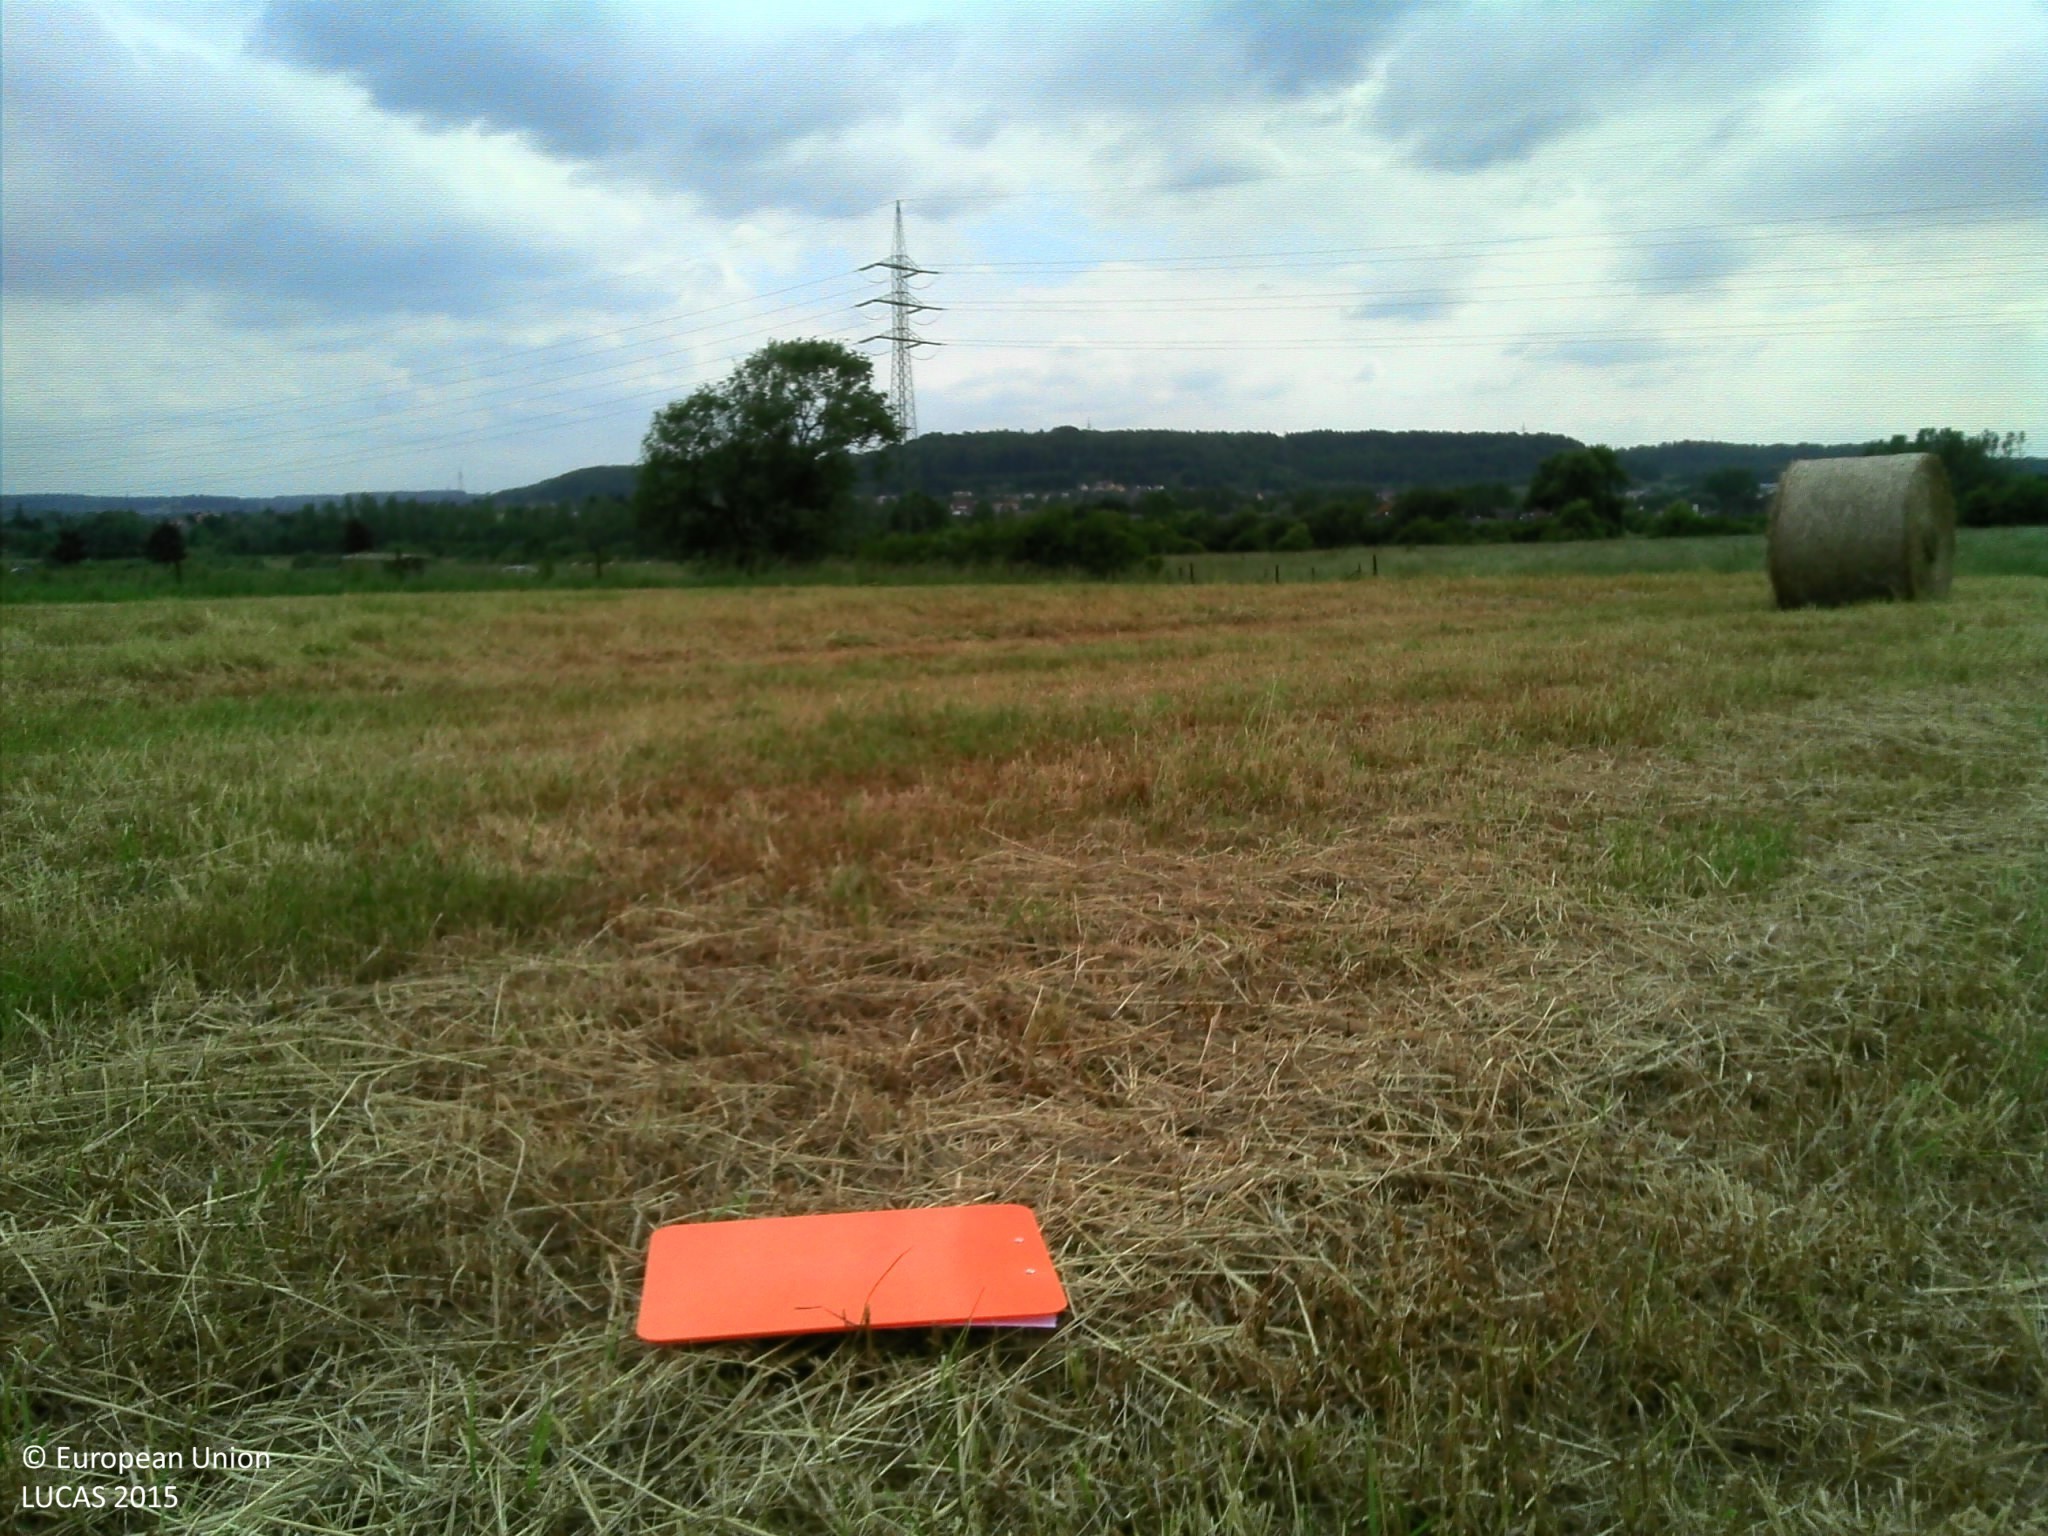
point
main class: Cropland
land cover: Temporary grasslands
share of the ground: > 75 %
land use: Agriculture (excluding fallow land and kitchen gardens)
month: June
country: LU
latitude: 49.5701
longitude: 5.8923
